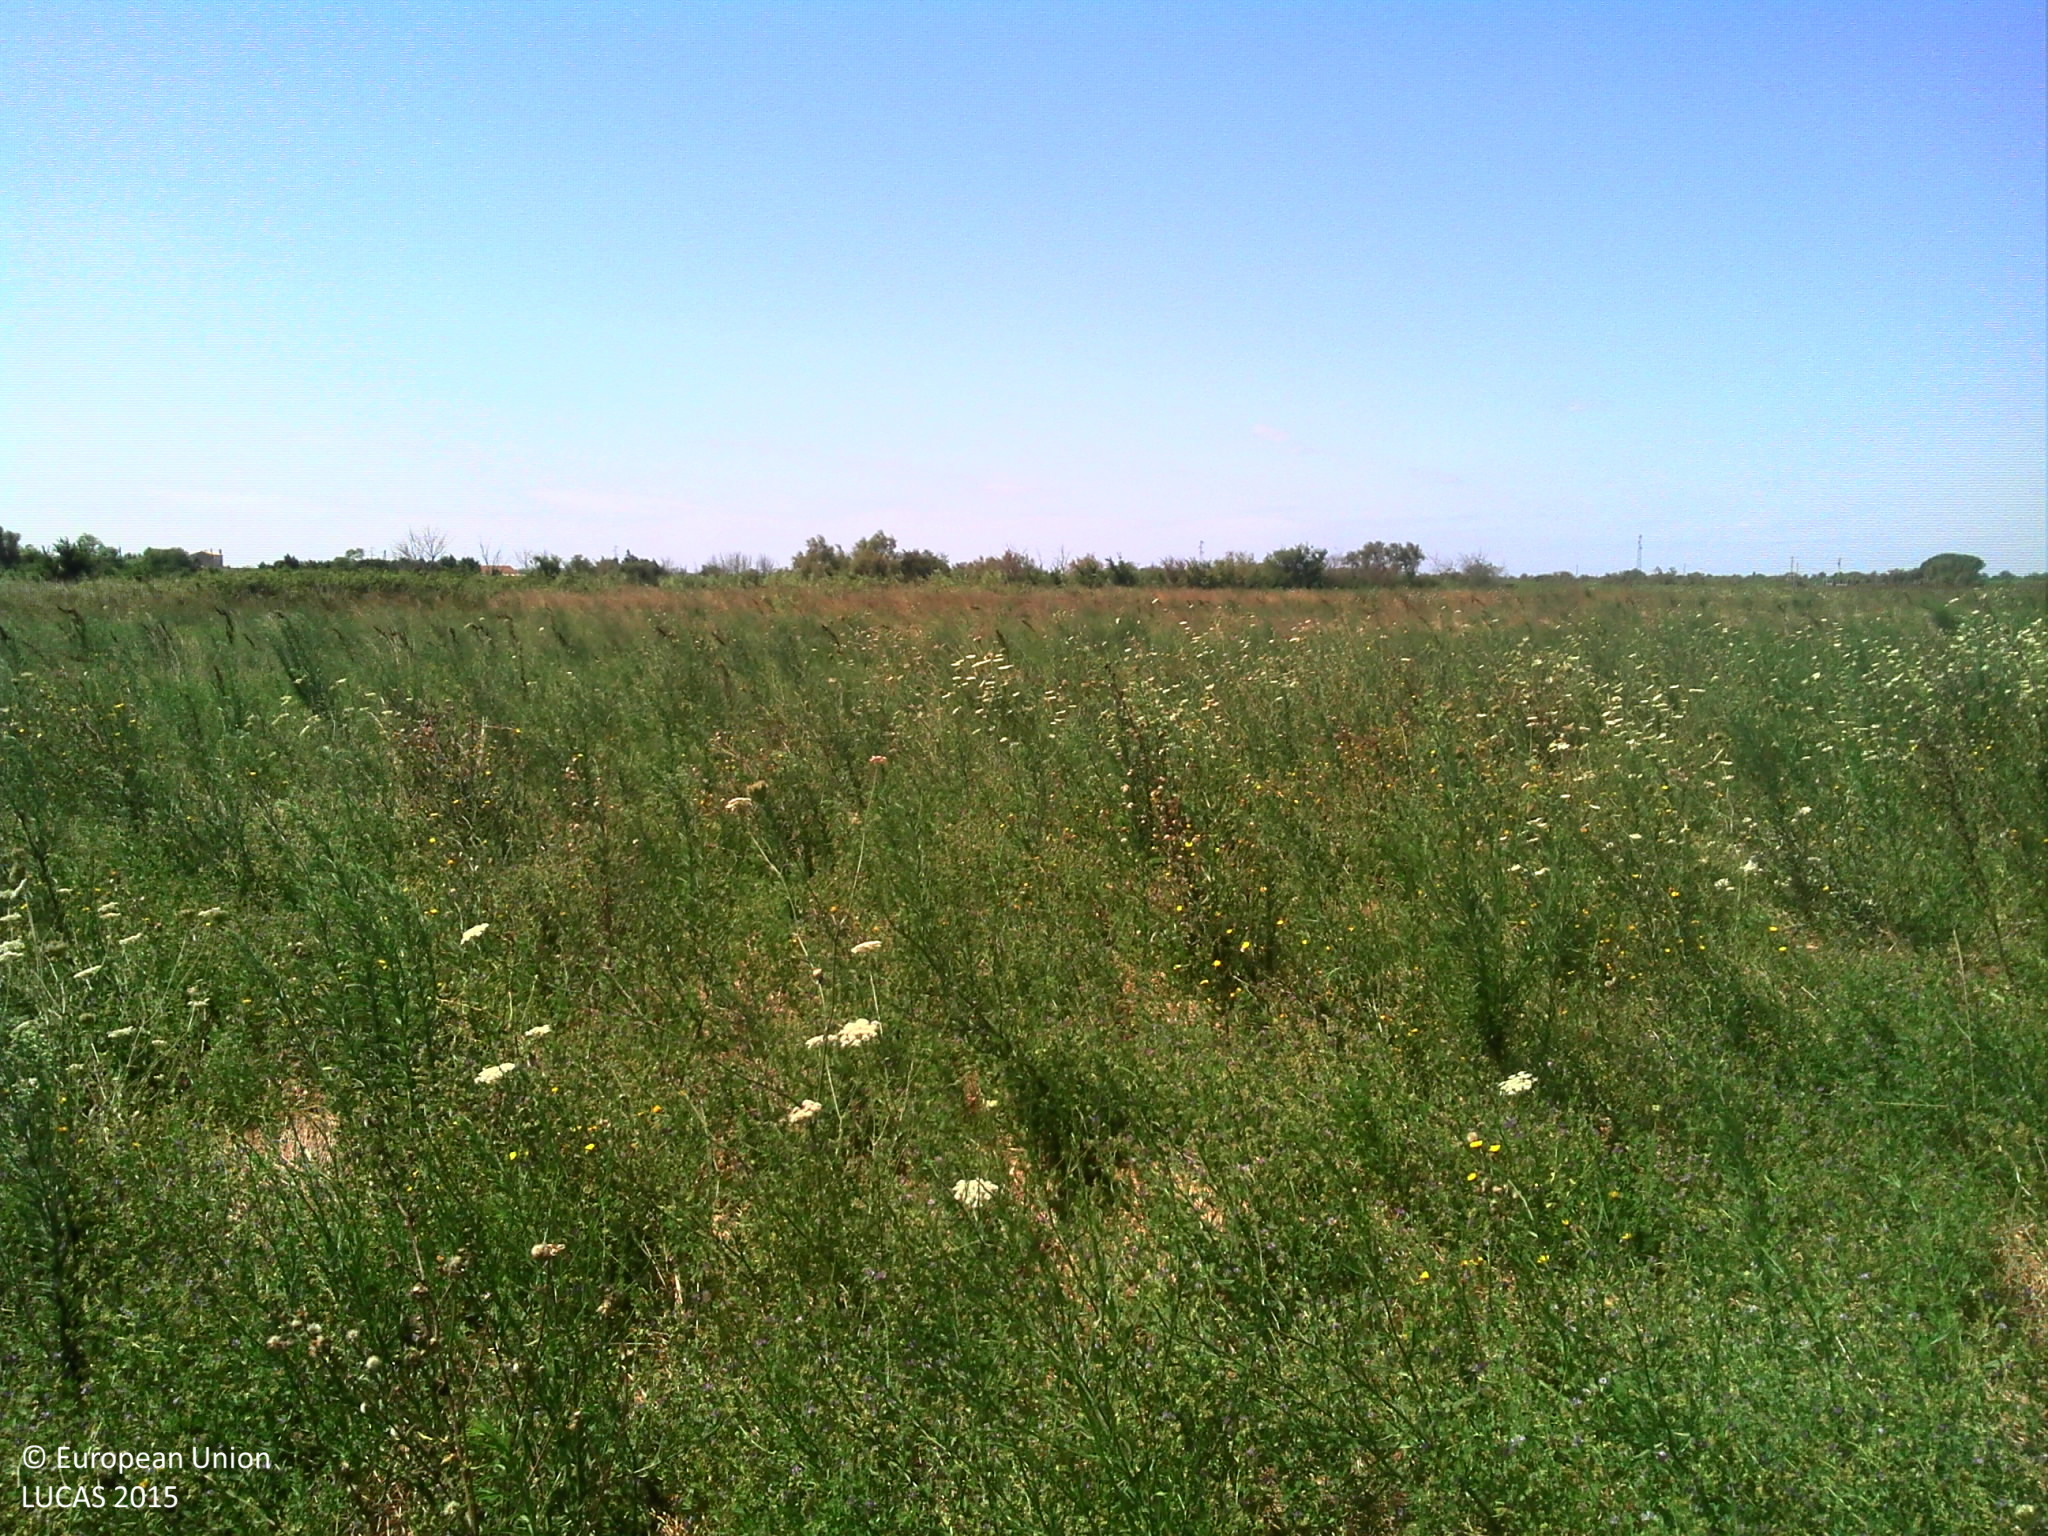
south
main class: Grassland
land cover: Grassland without tree/shrub cover
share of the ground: > 75 %
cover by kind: herbaceous plants 100 %
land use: Agriculture (excluding fallow land and kitchen gardens)
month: July
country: FR
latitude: 43.4743
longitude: 4.7067
